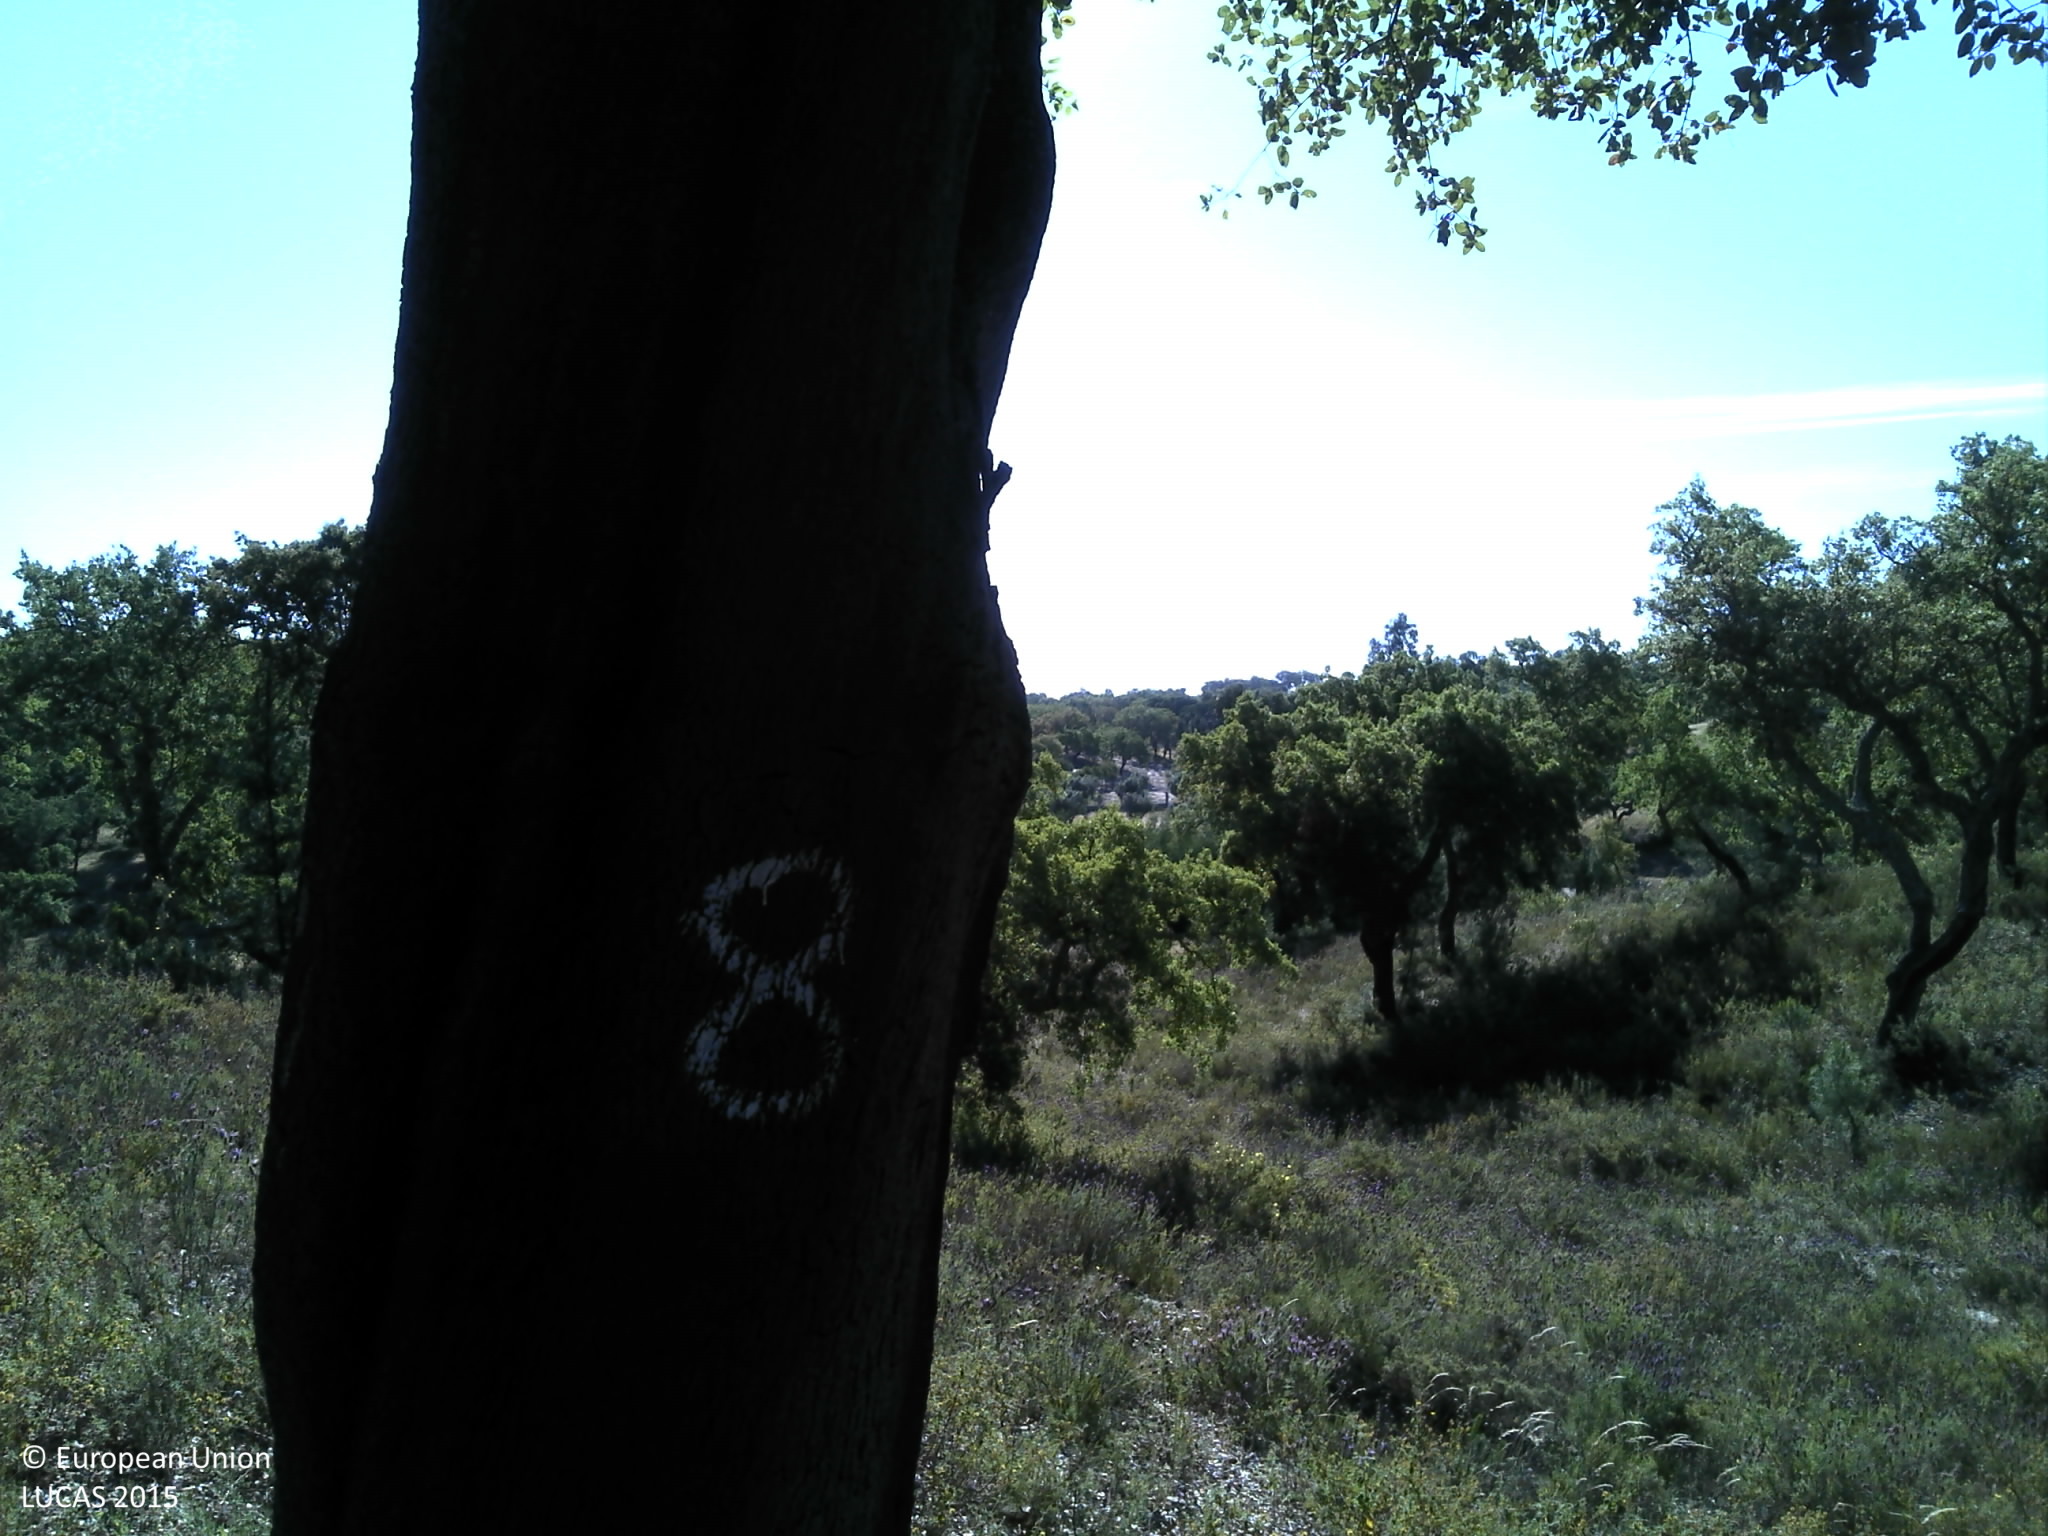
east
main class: Woodland
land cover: Broadleaved woodland
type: broadleaved evergreen forest
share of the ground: 10 - 25 %
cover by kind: shrubs 50 %, broadleaved forest trees 25 %, unconsolidated bare surface 15 %, herbaceous plants 10 %
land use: Forestry
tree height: > 5 m
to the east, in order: Broadleaved woodland; Tracks; Fences; Grassland without tree/shrub cover; Shrubland with sparse tree cover; Rivers and streams; Shrubland with sparse tree cover; Grassland without tree/shrub cover; Fences; Olive groves
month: May
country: PT
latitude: 39.1989
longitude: -7.9895
